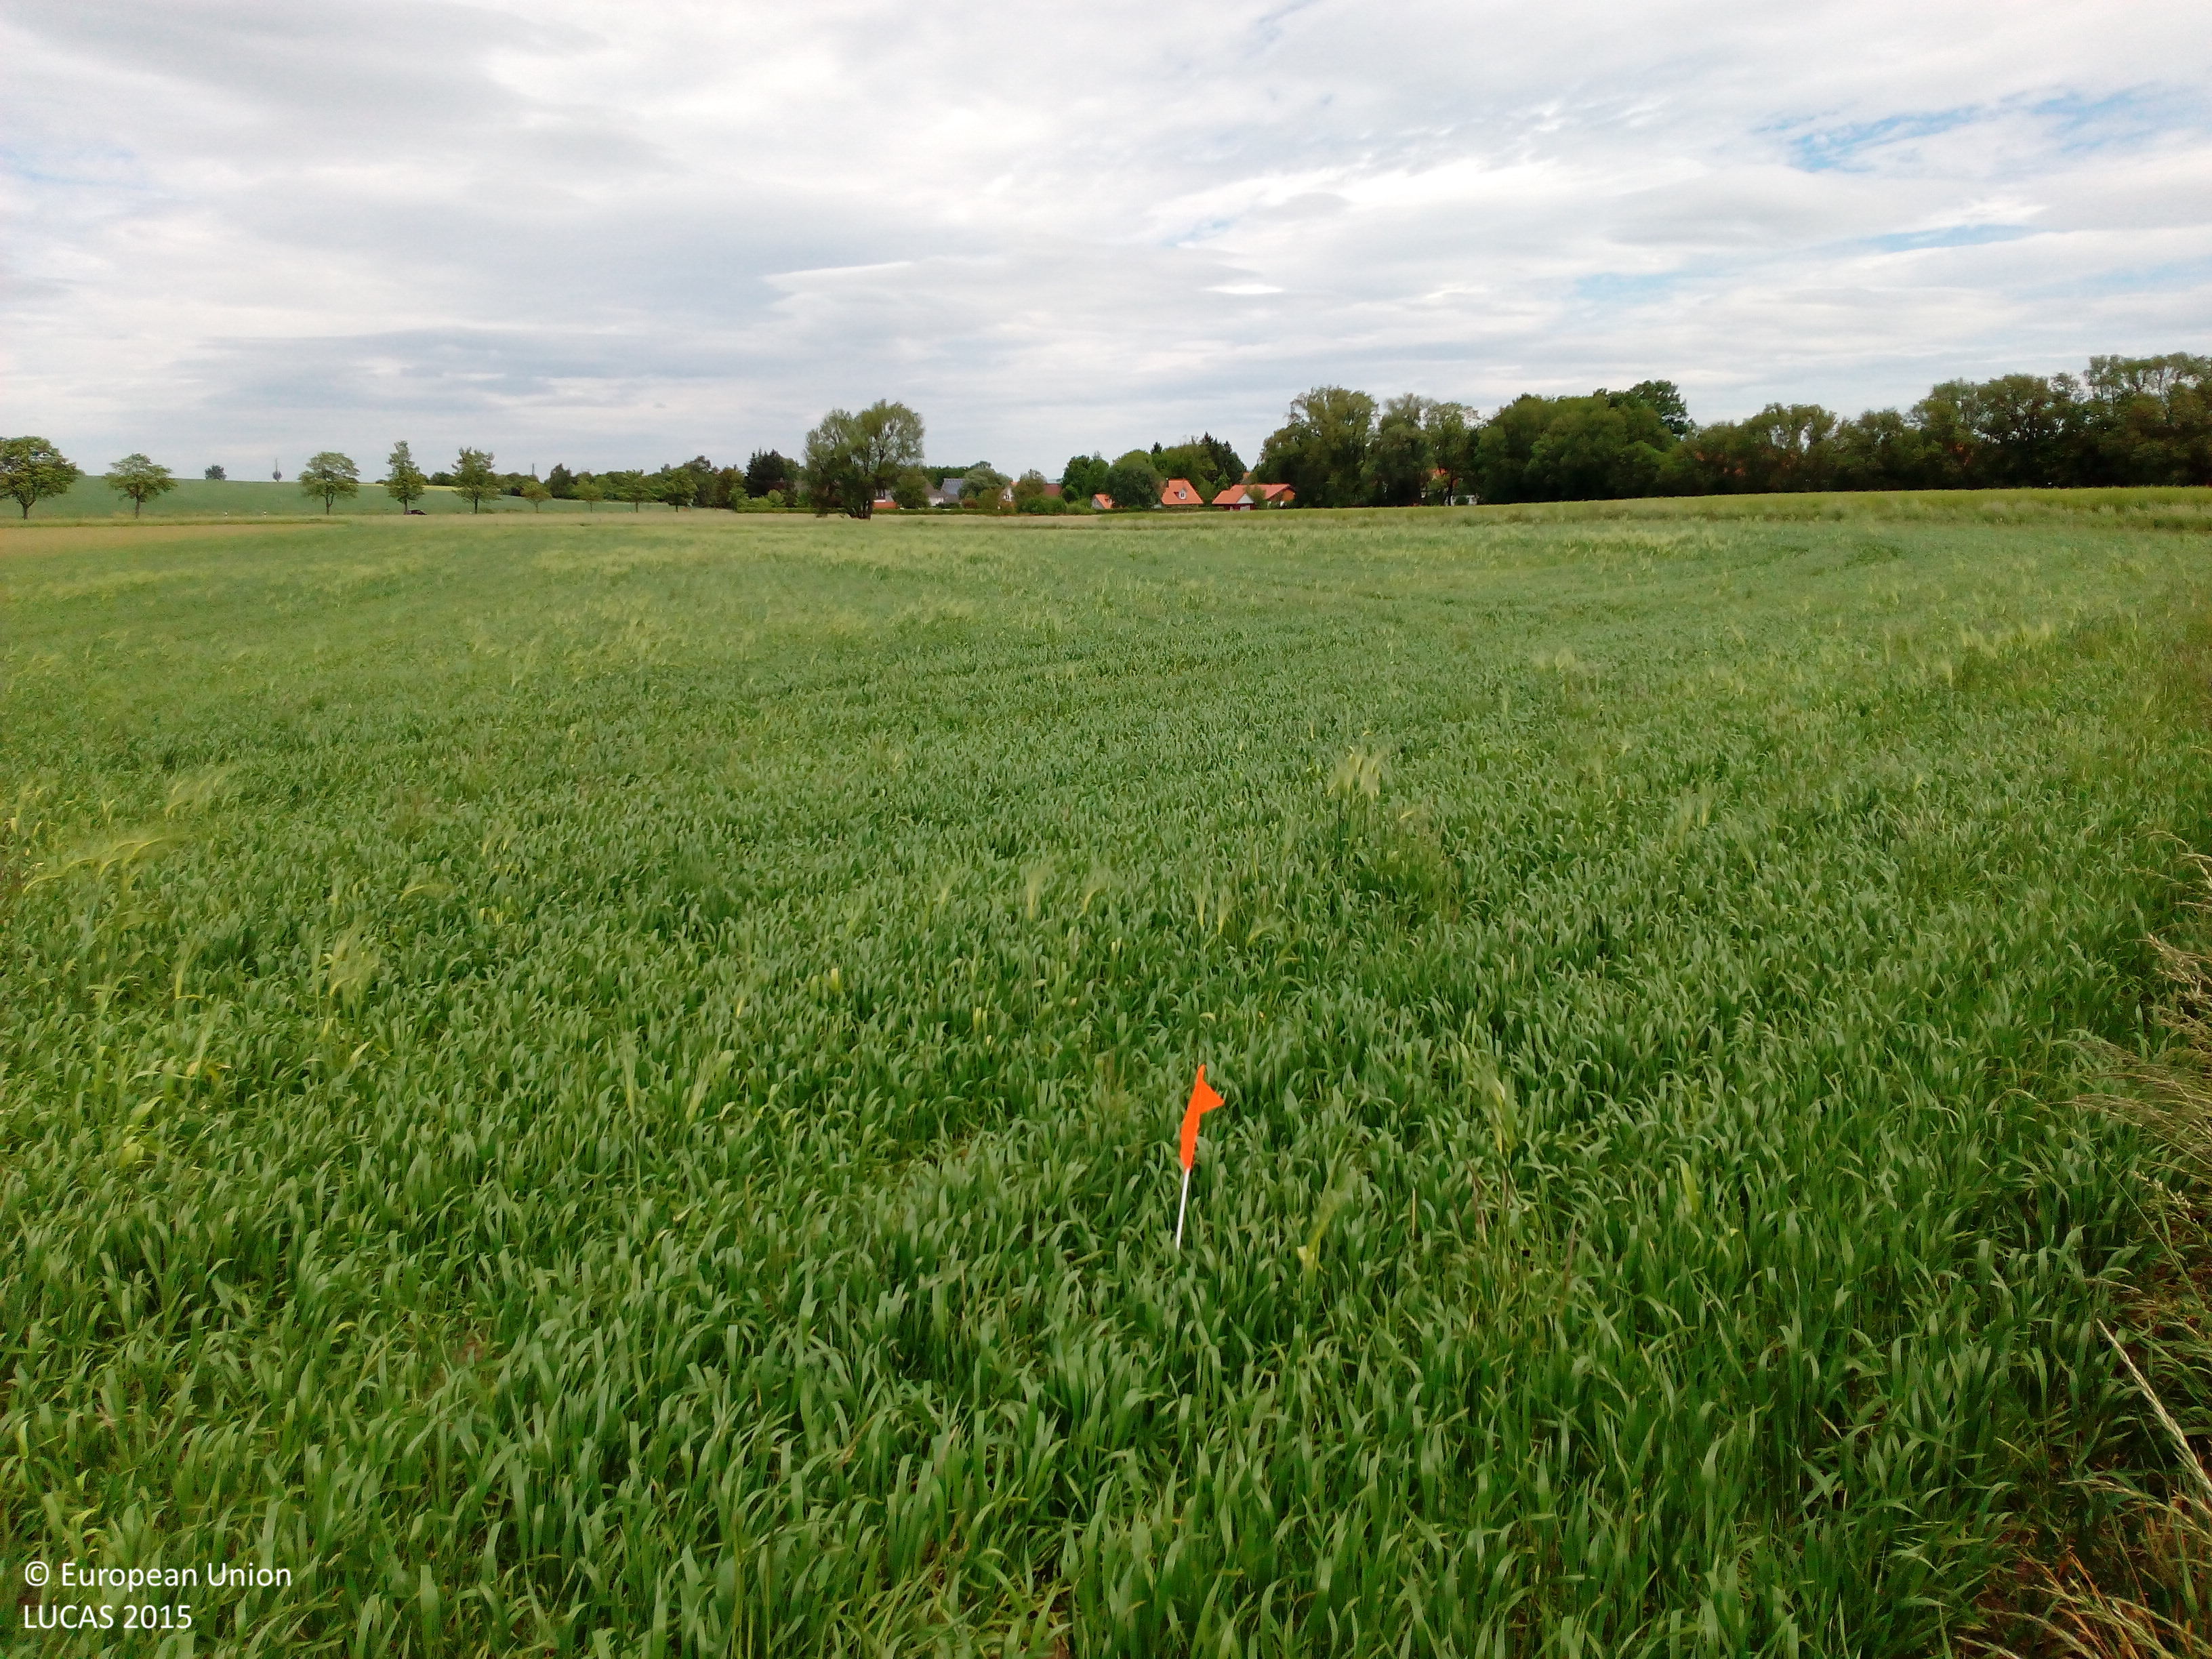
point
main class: Cropland
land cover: Temporary grasslands
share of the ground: > 75 %
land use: Agriculture (excluding fallow land and kitchen gardens)
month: June
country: DE
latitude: 51.9088
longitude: 10.5667
